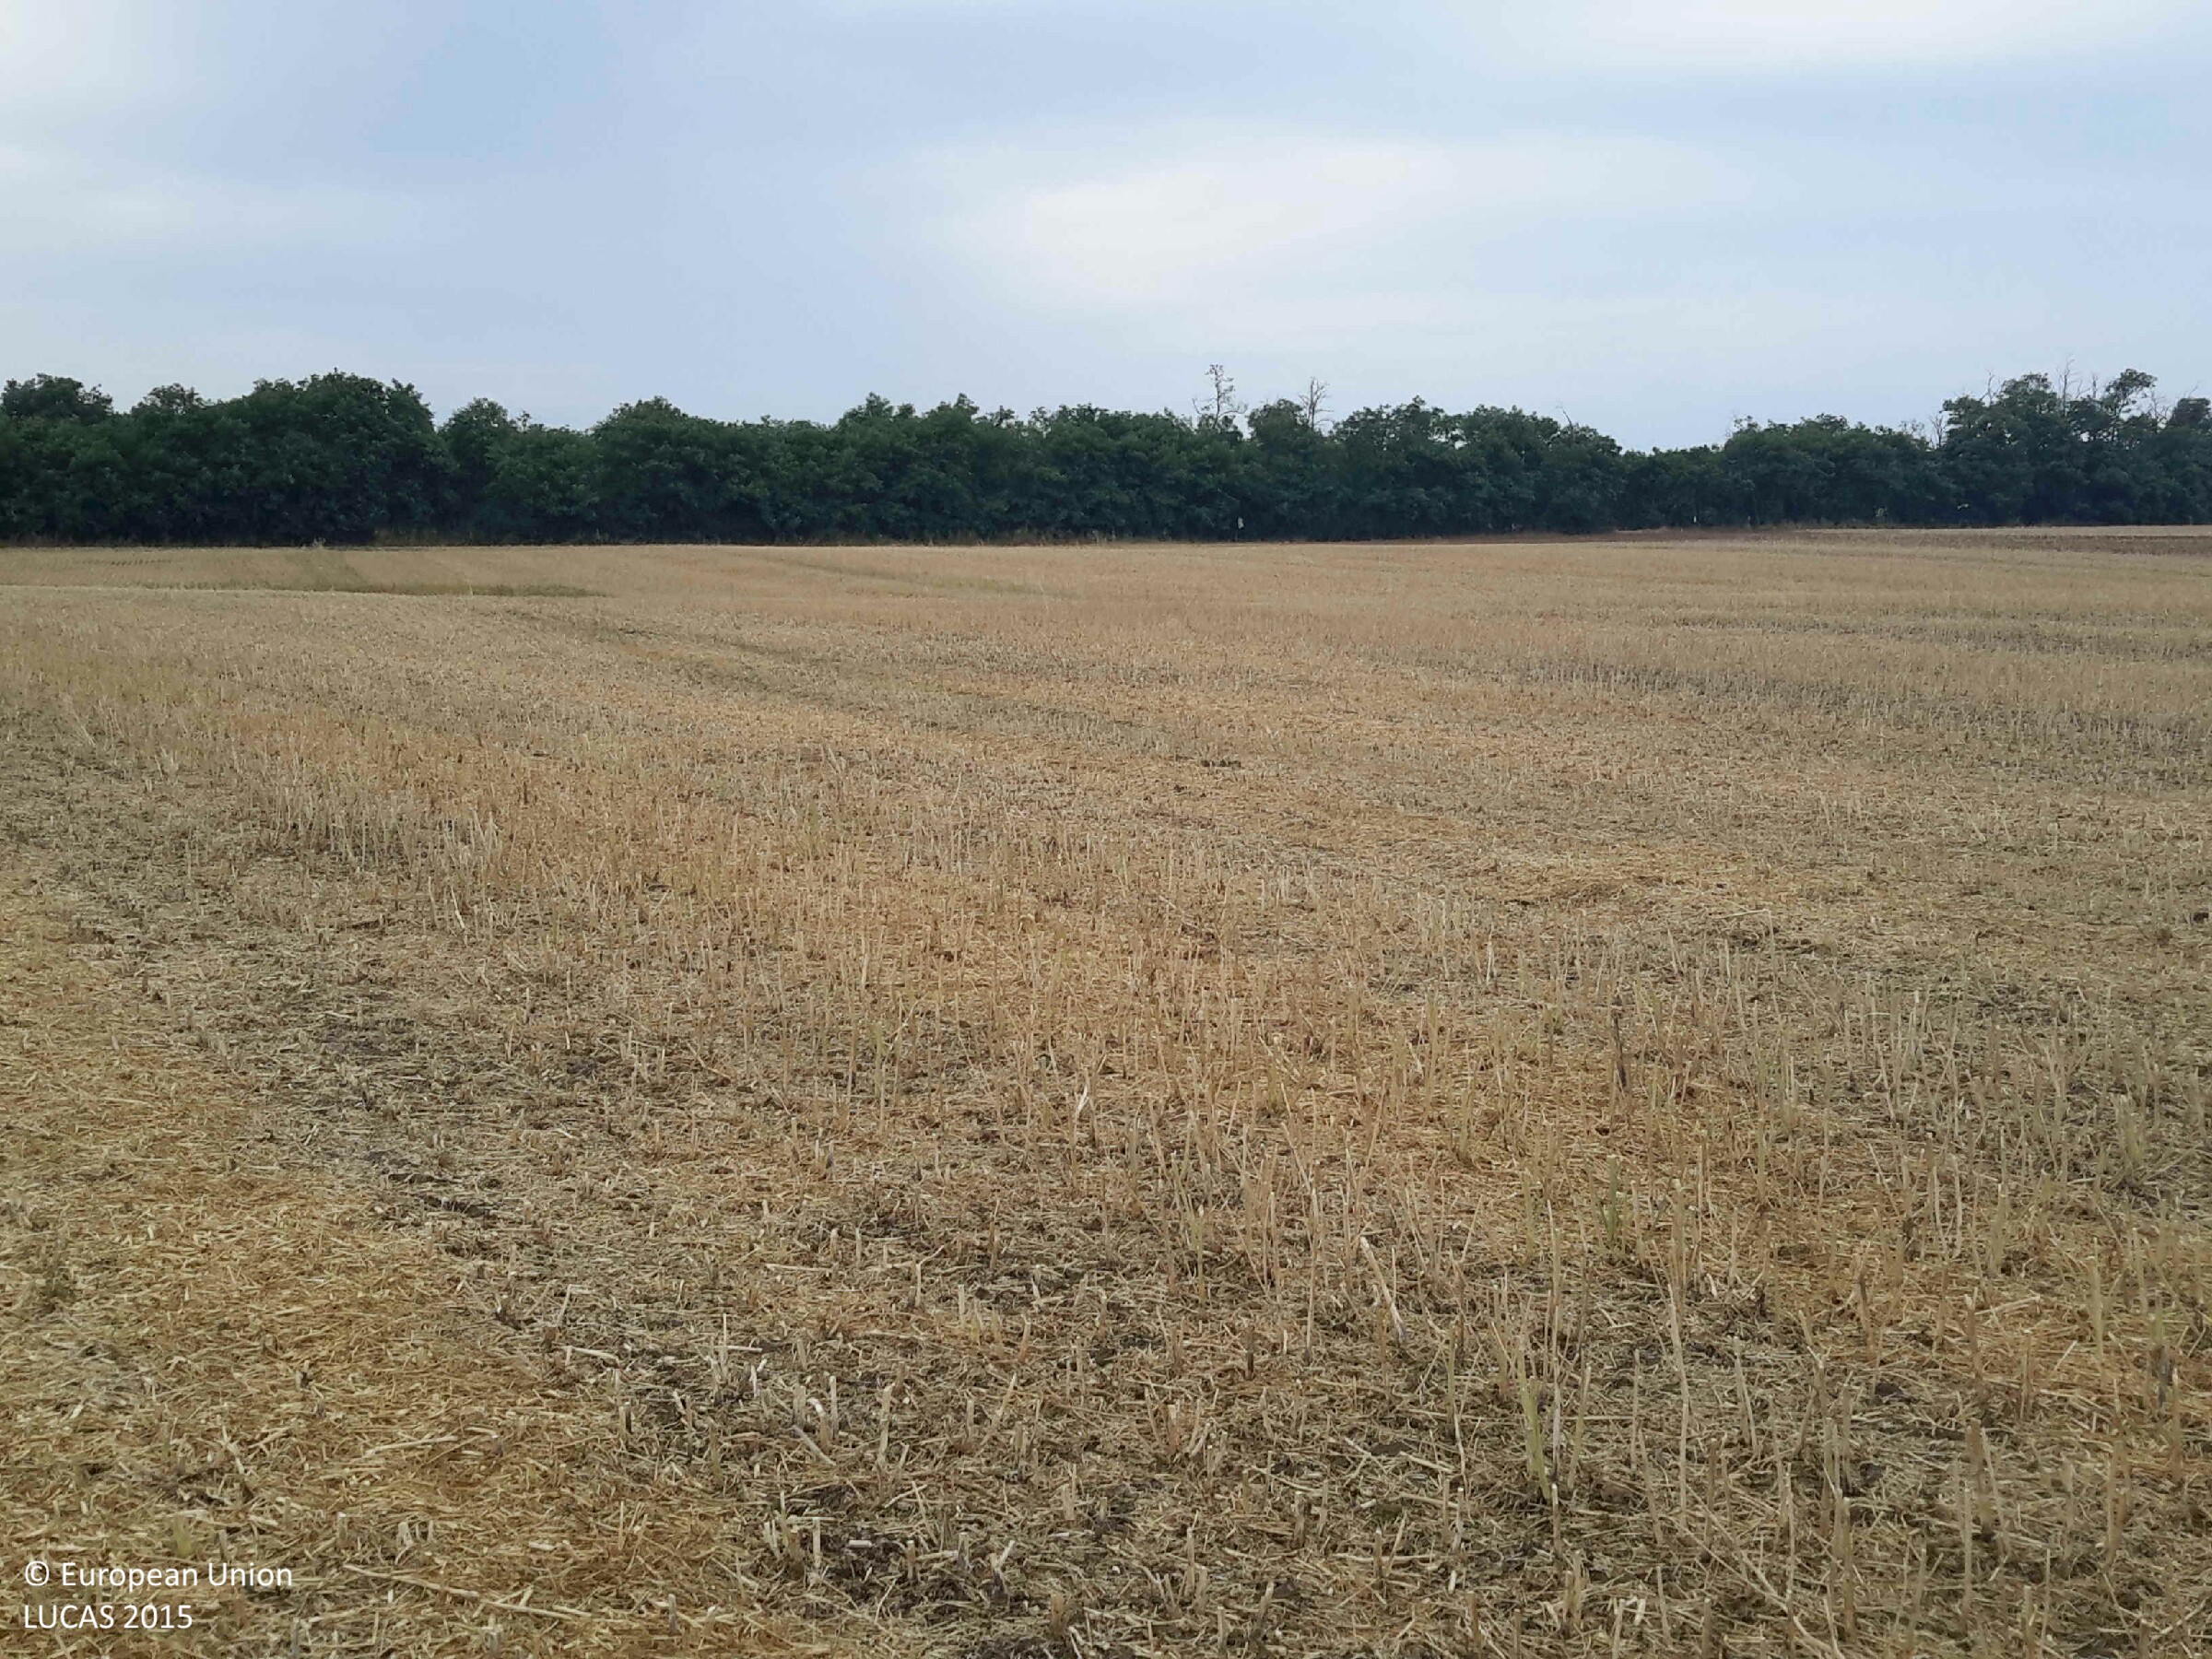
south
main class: Cropland
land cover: Rape and turnip rape
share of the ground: 10 - 25 %
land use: Agriculture (excluding fallow land and kitchen gardens)
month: July
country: HU
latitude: 47.4472
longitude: 17.1811
